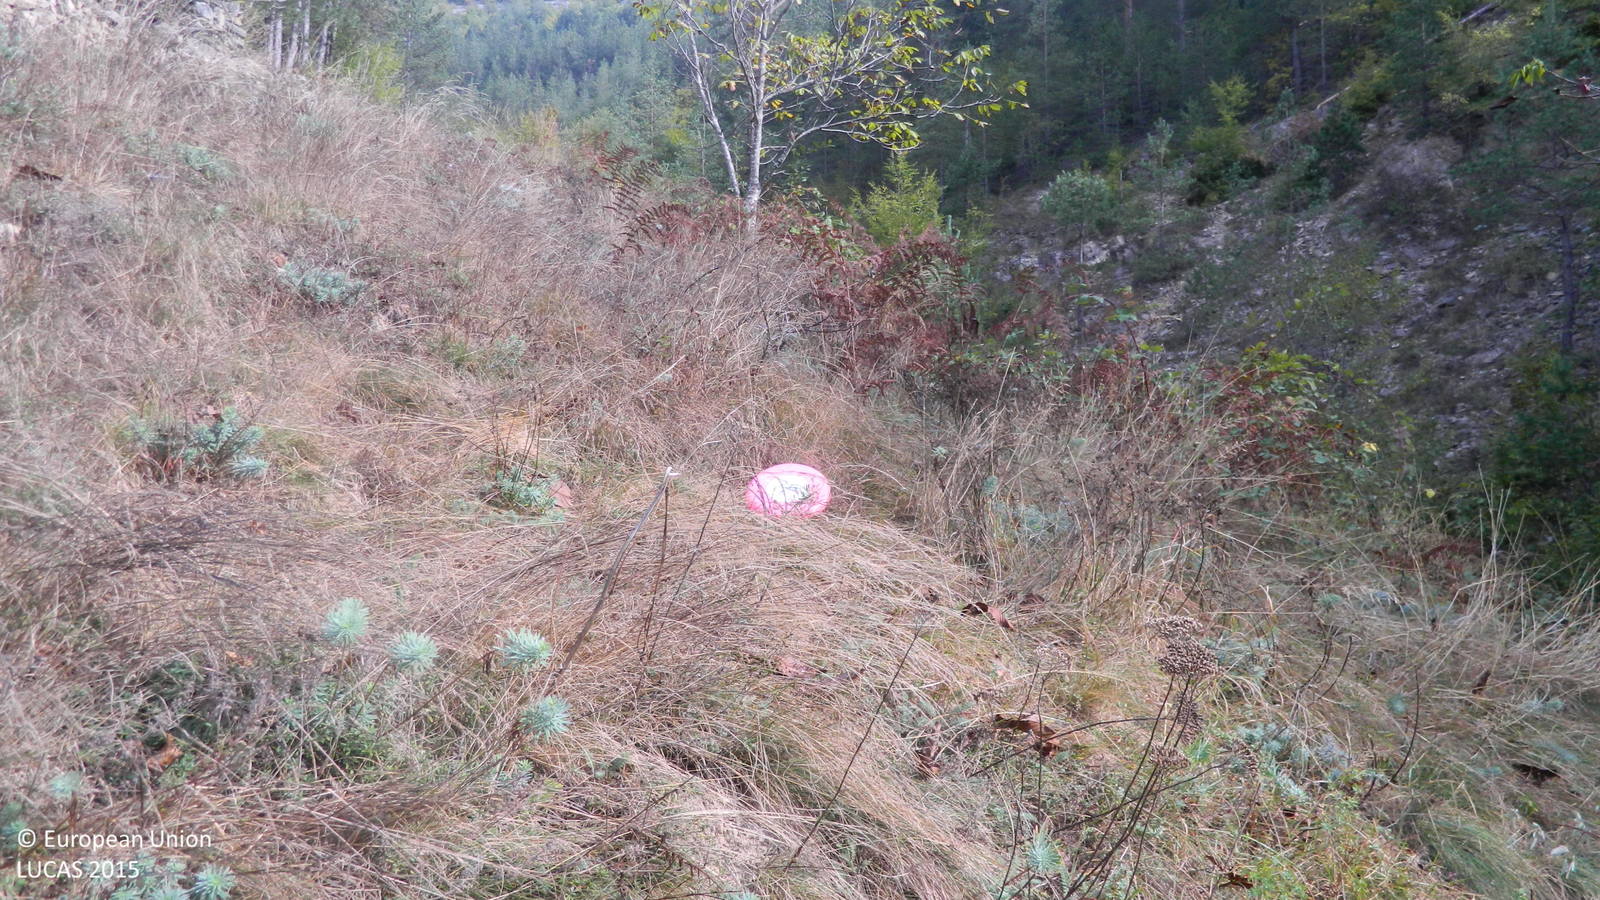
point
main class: Grassland
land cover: Grassland with sparse tree/shrub cover
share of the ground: > 75 %
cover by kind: herbaceous plants 85 %, broadleaved forest trees 5 %, shrubs 5 %, unconsolidated bare surface 5 %
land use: Agriculture (excluding fallow land and kitchen gardens)
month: October
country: BG
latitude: 41.5732
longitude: 24.8334
